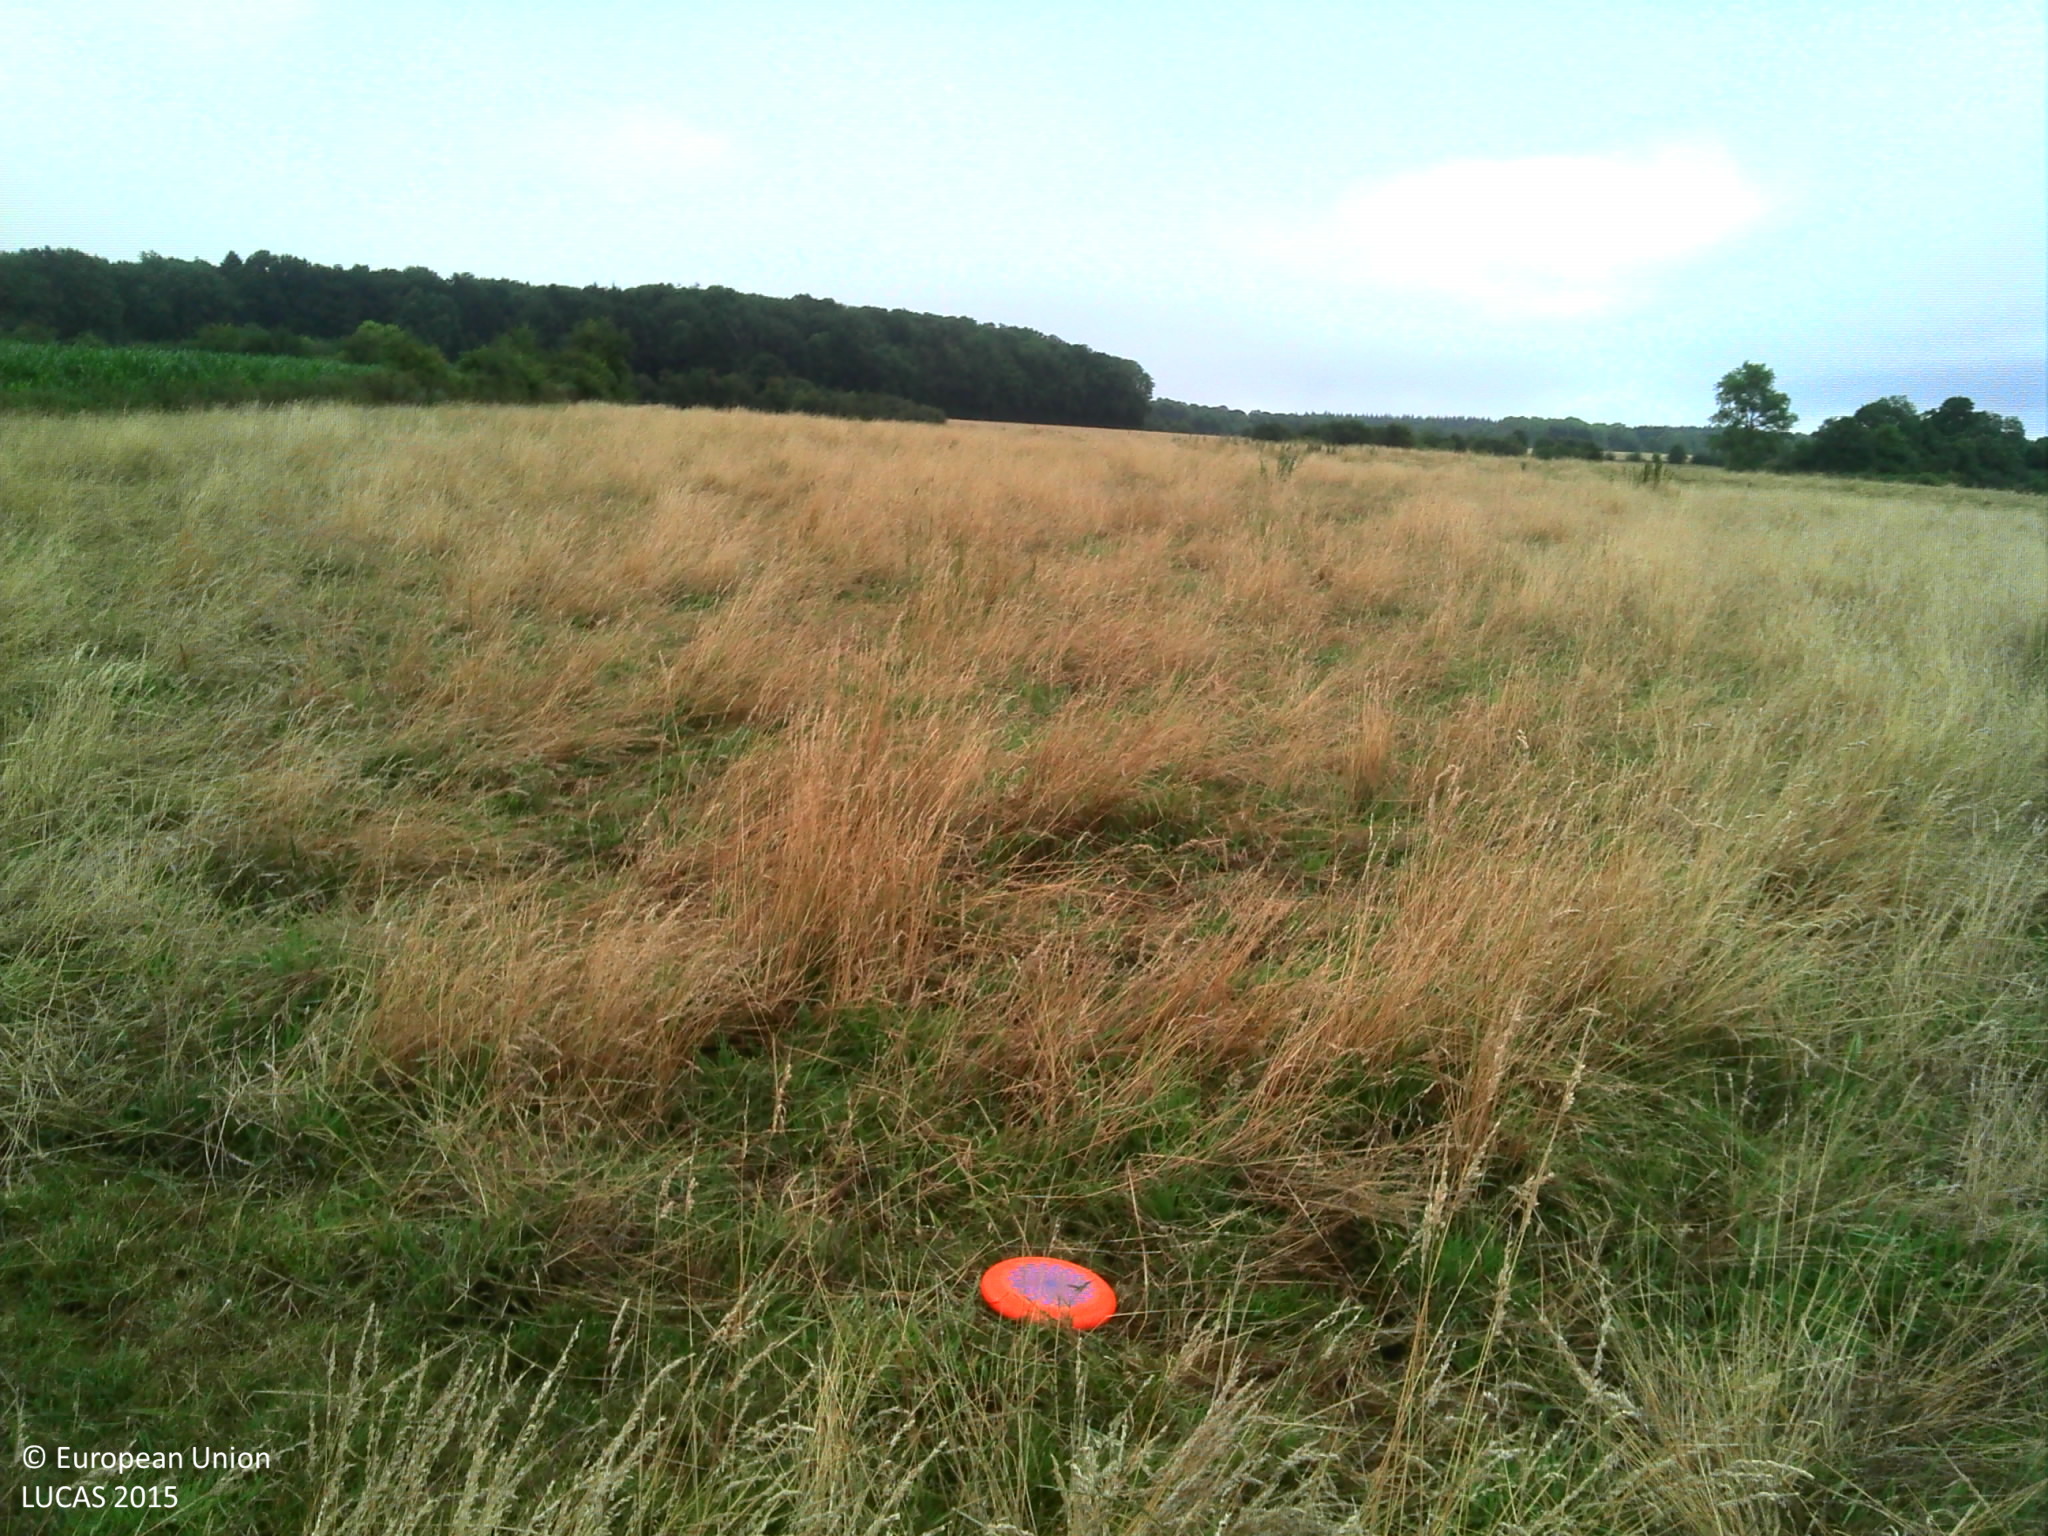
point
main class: Grassland
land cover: Grassland without tree/shrub cover
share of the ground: > 75 %
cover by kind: herbaceous plants 100 %
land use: Agriculture (excluding fallow land and kitchen gardens)
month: July
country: BE
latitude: 50.2006
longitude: 4.6025
